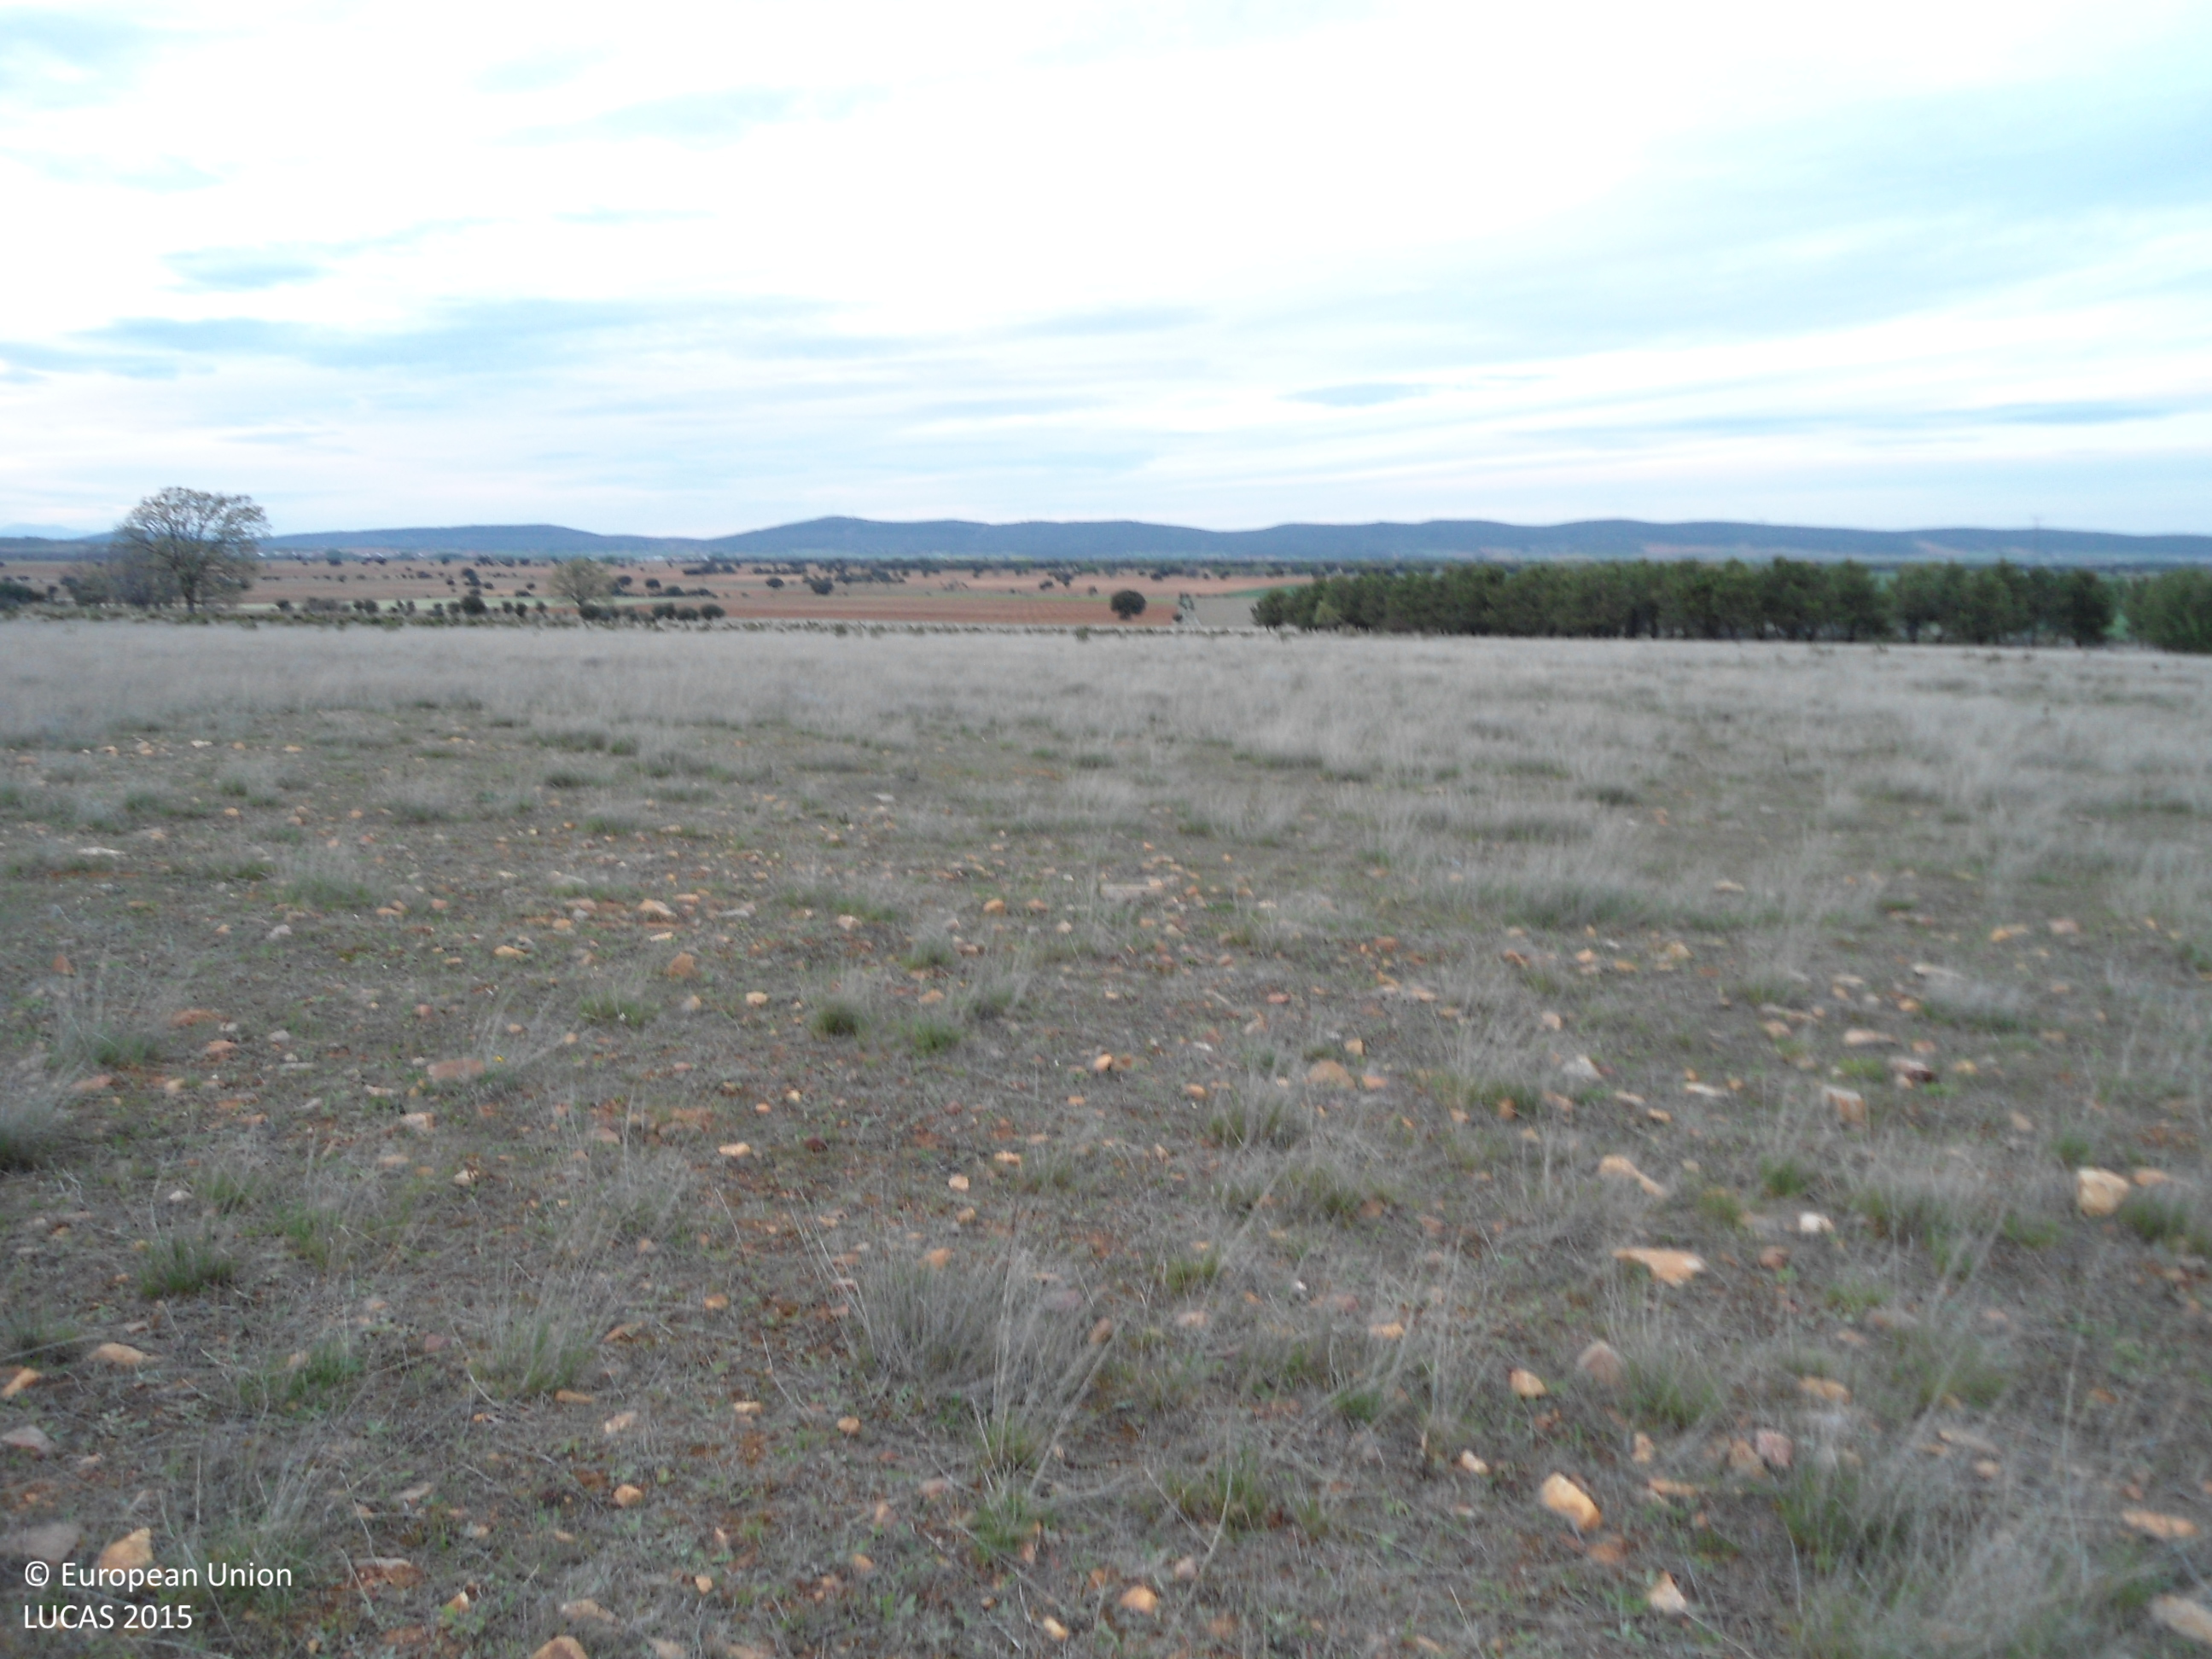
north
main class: Grassland
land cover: Spontaneously vegetated surfaces
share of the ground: > 75 %
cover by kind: herbaceous plants 100 %
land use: Agriculture (excluding fallow land and kitchen gardens)
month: April
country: ES
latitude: 41.7862
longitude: -5.9414
